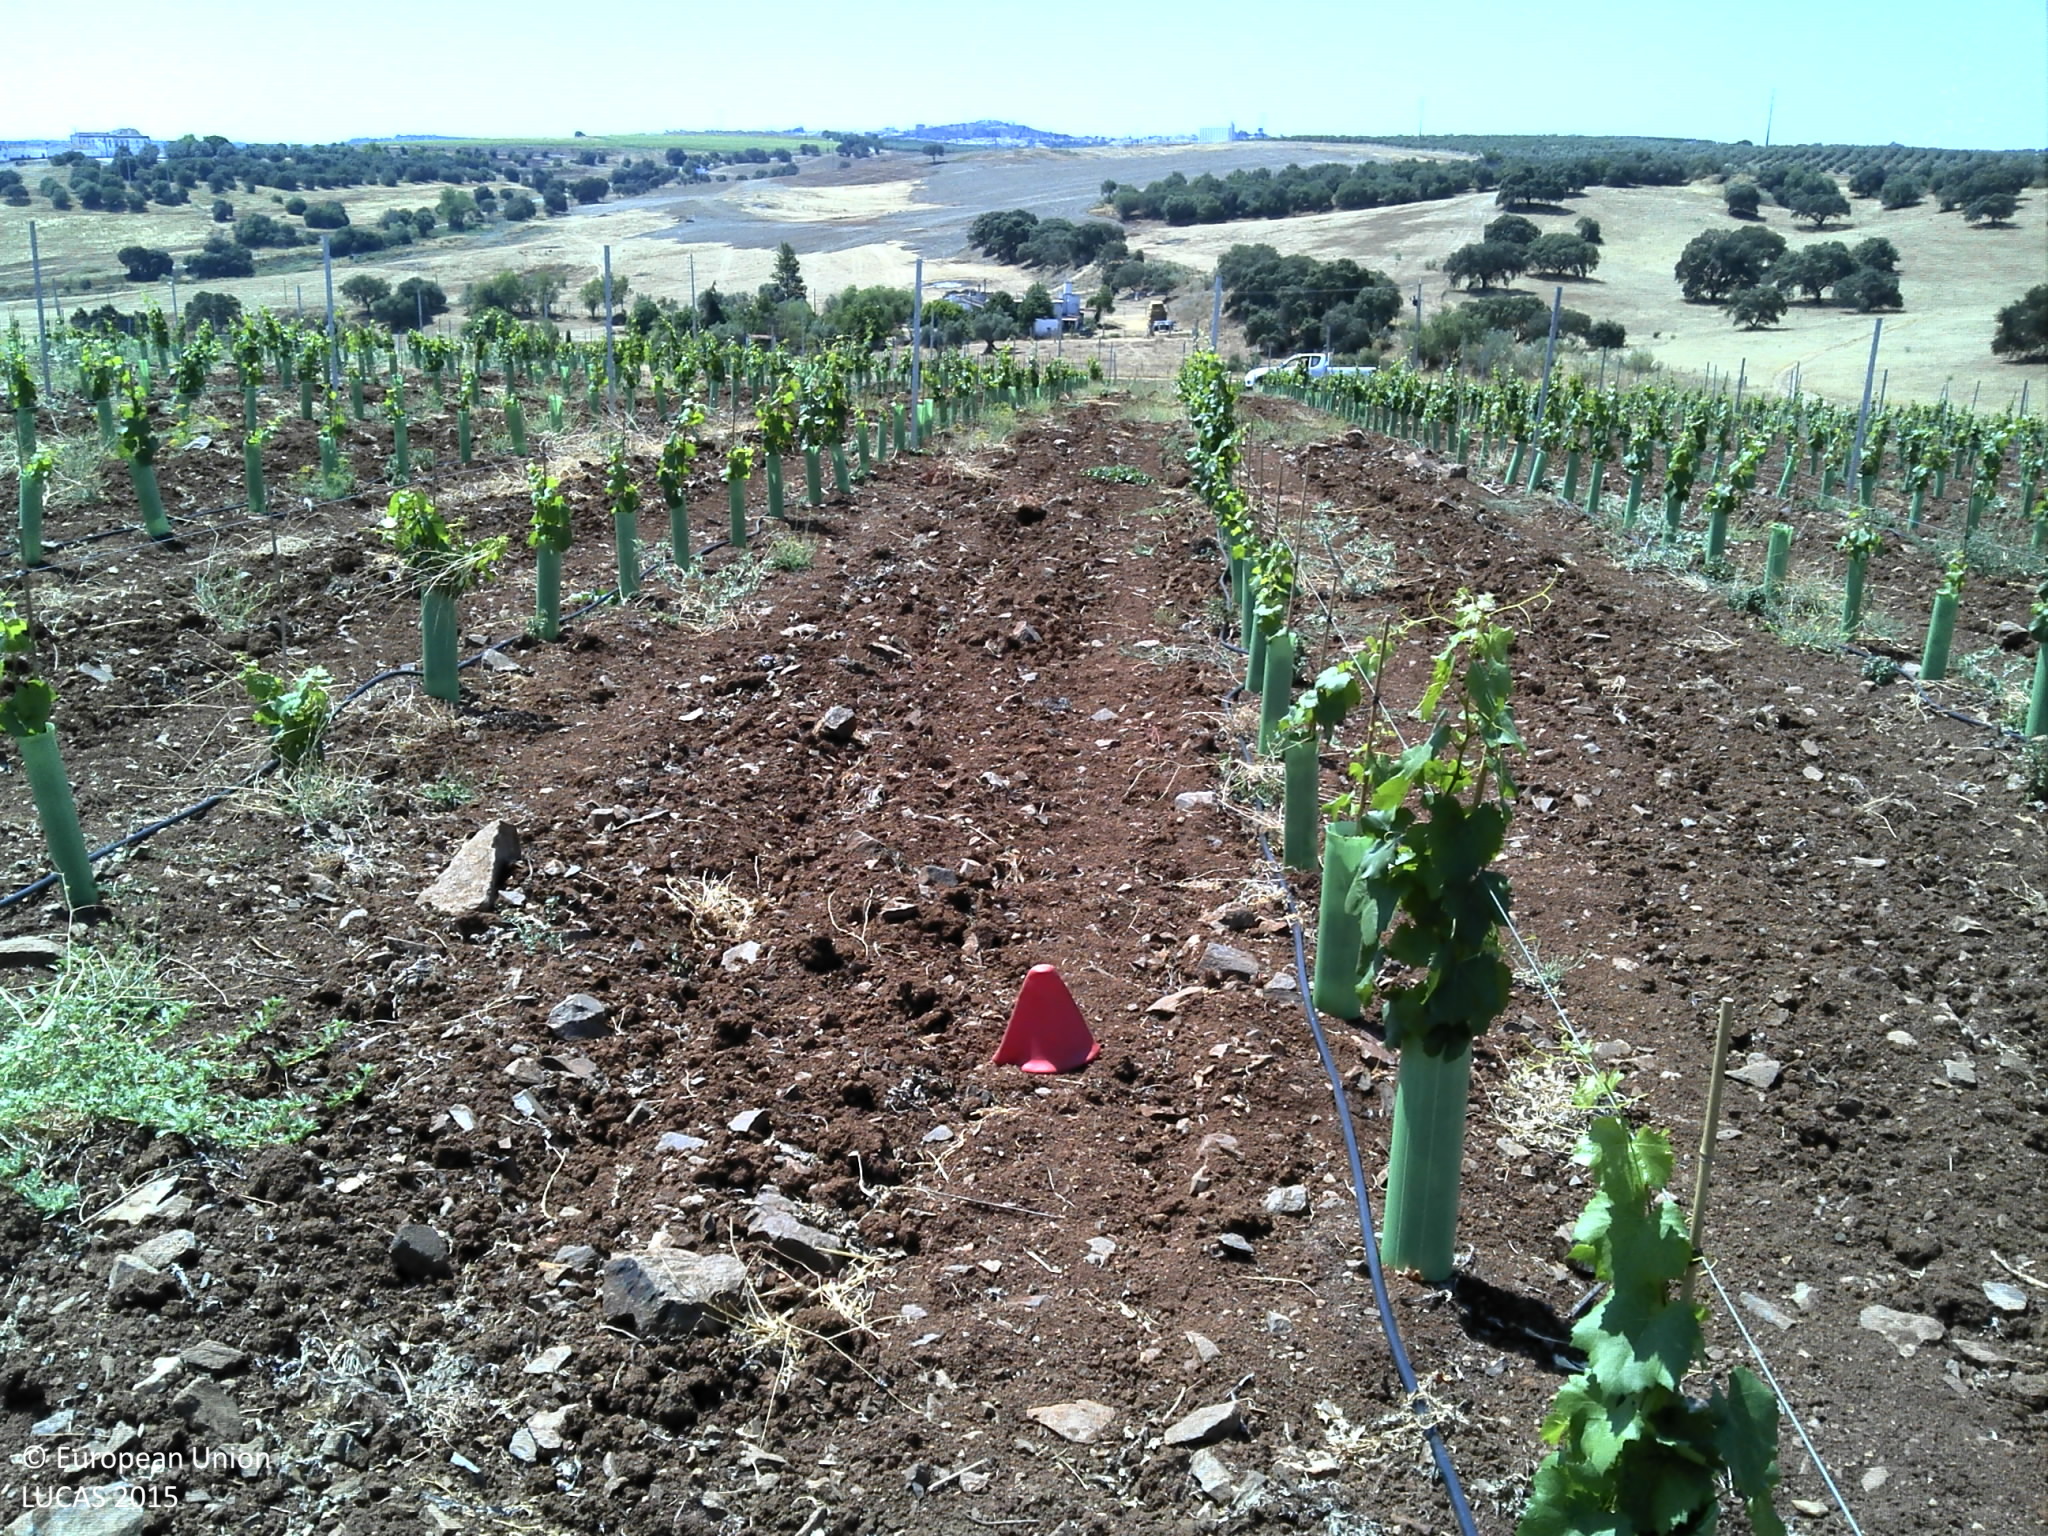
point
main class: Cropland
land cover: Vineyards
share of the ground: 10 - 25 %
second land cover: Other bare soil
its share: > 75 %
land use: Agriculture (excluding fallow land and kitchen gardens)
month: June
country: PT
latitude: 37.9766
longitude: -7.6099
